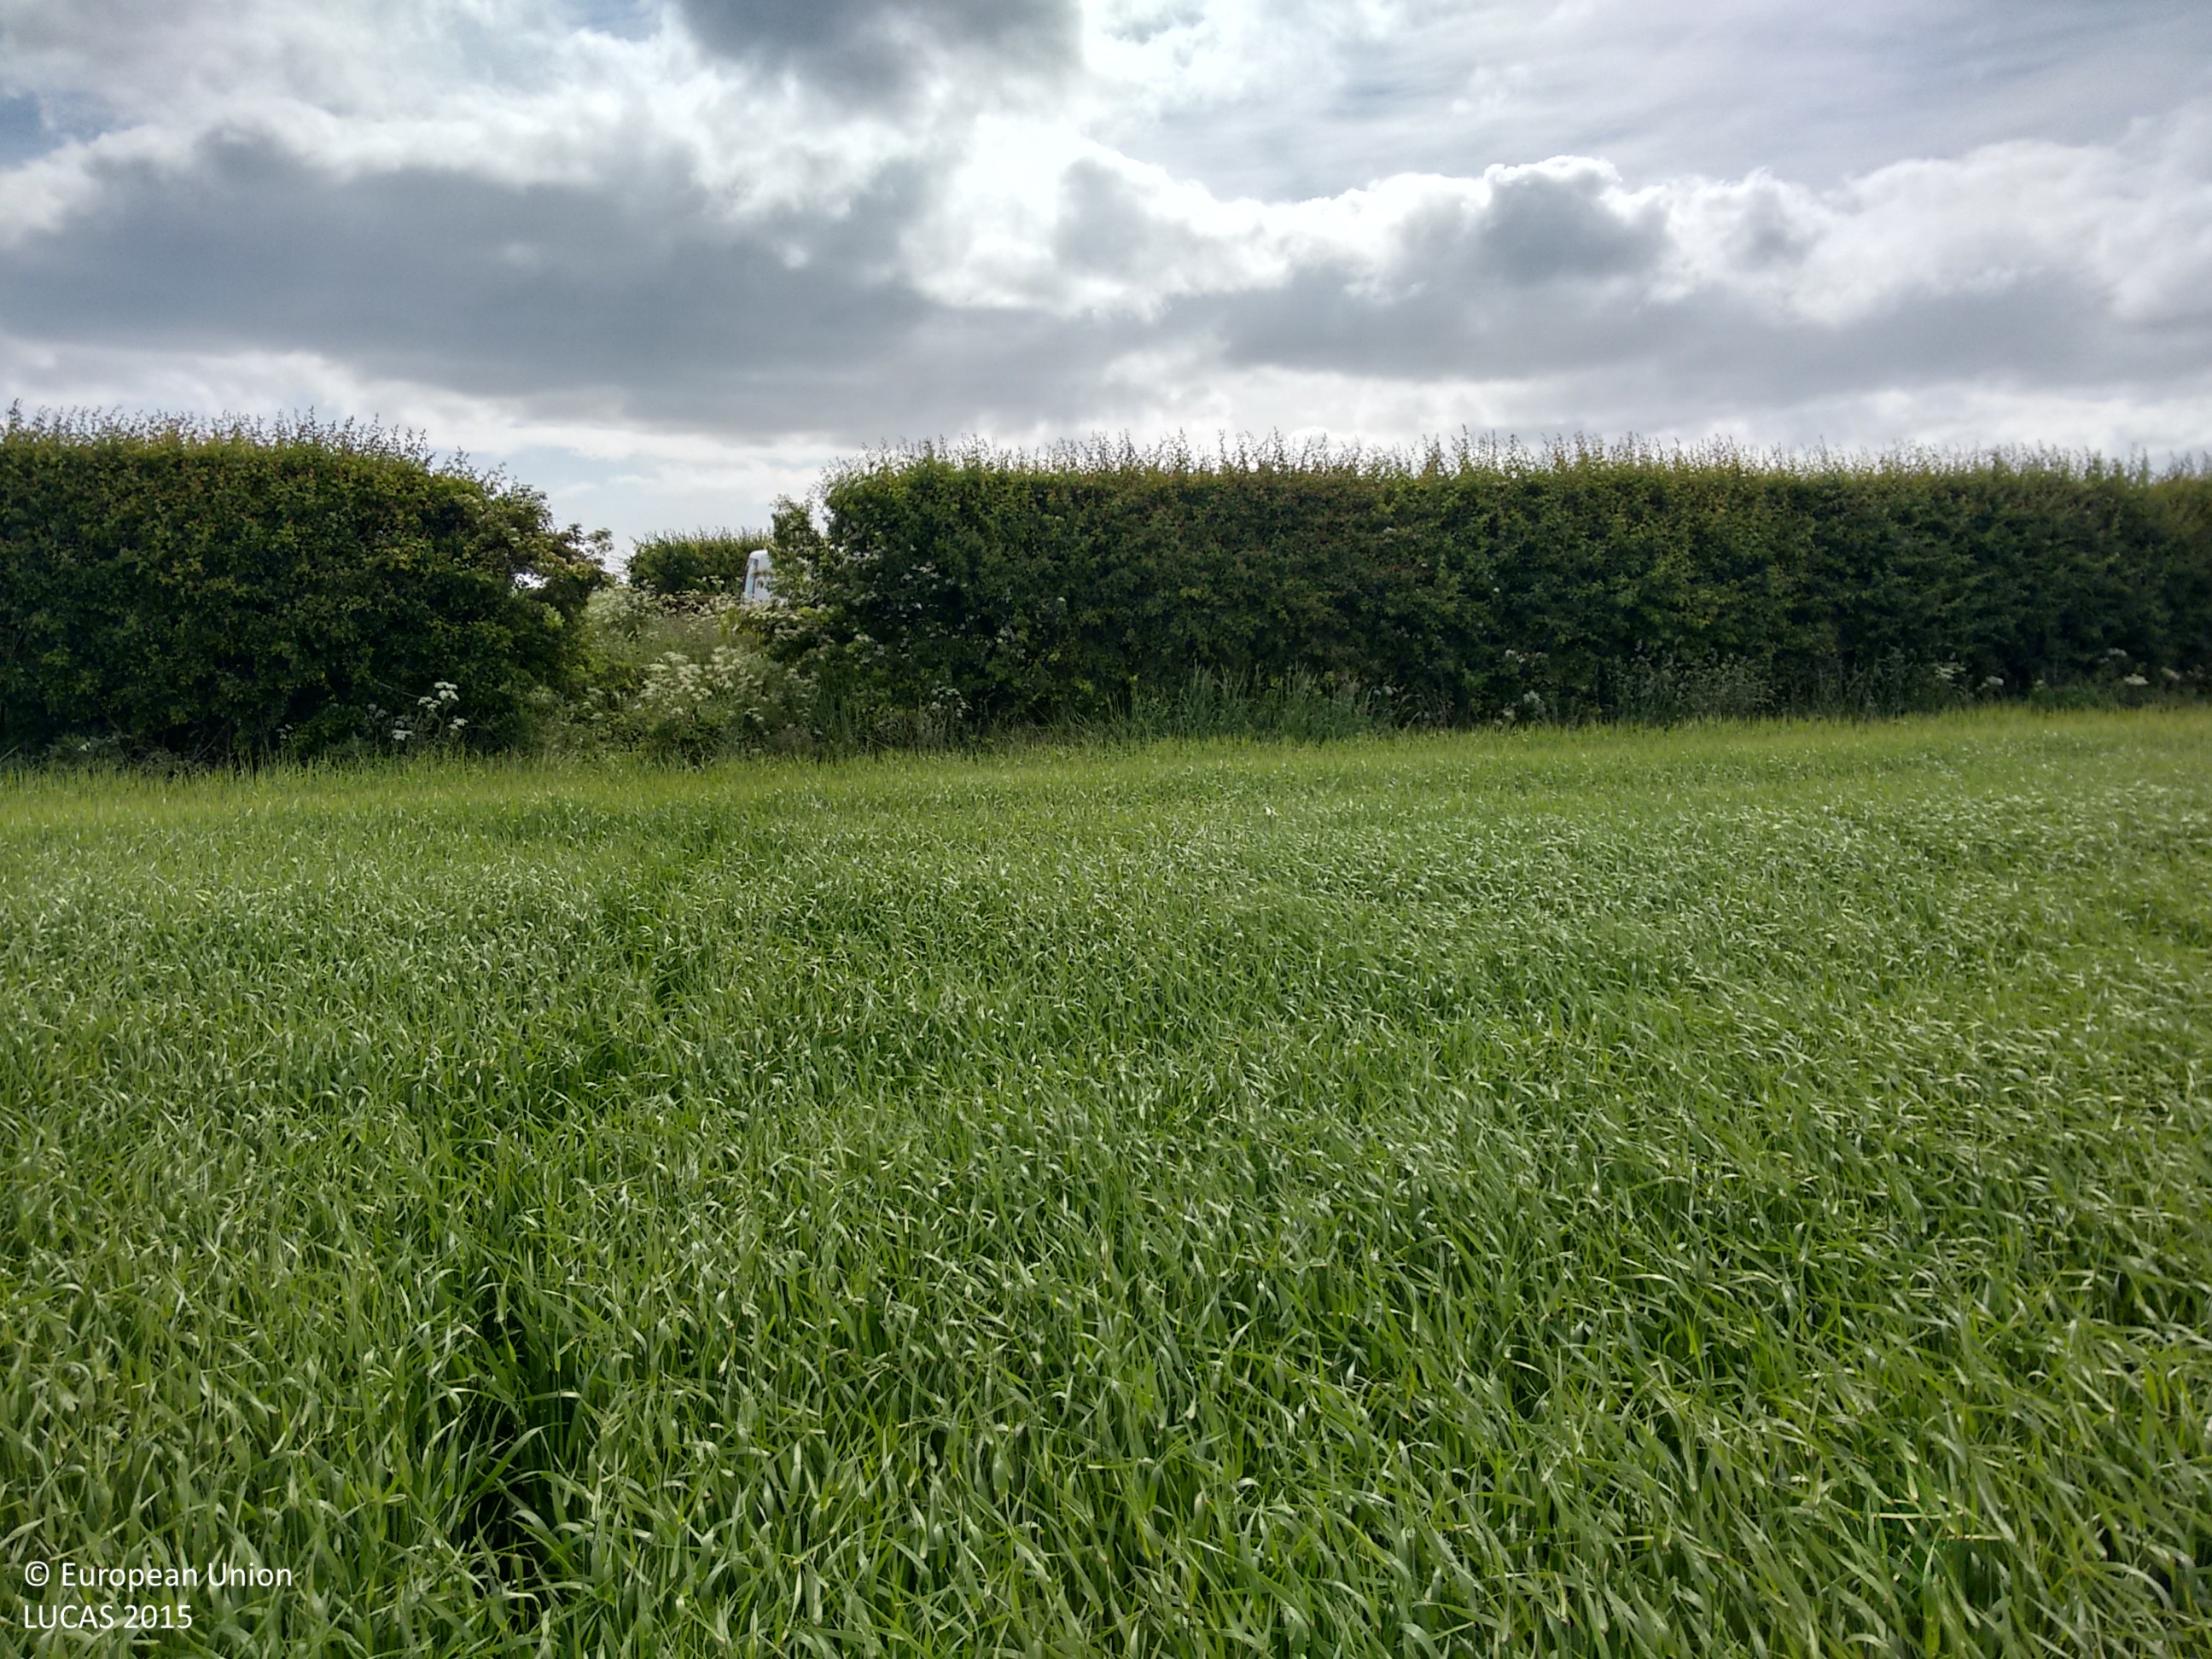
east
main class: Cropland
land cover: Barley
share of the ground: > 75 %
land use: Agriculture (excluding fallow land and kitchen gardens)
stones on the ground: < 10 %
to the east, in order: Barley; Grass margins; Managed hedges; Grass margins; Paved roads, cycling and walking lanes; Grass margins; Managed hedges; Grass margins; Rape and turnip rape
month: June
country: GB
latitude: 54.1447
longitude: -0.2444
